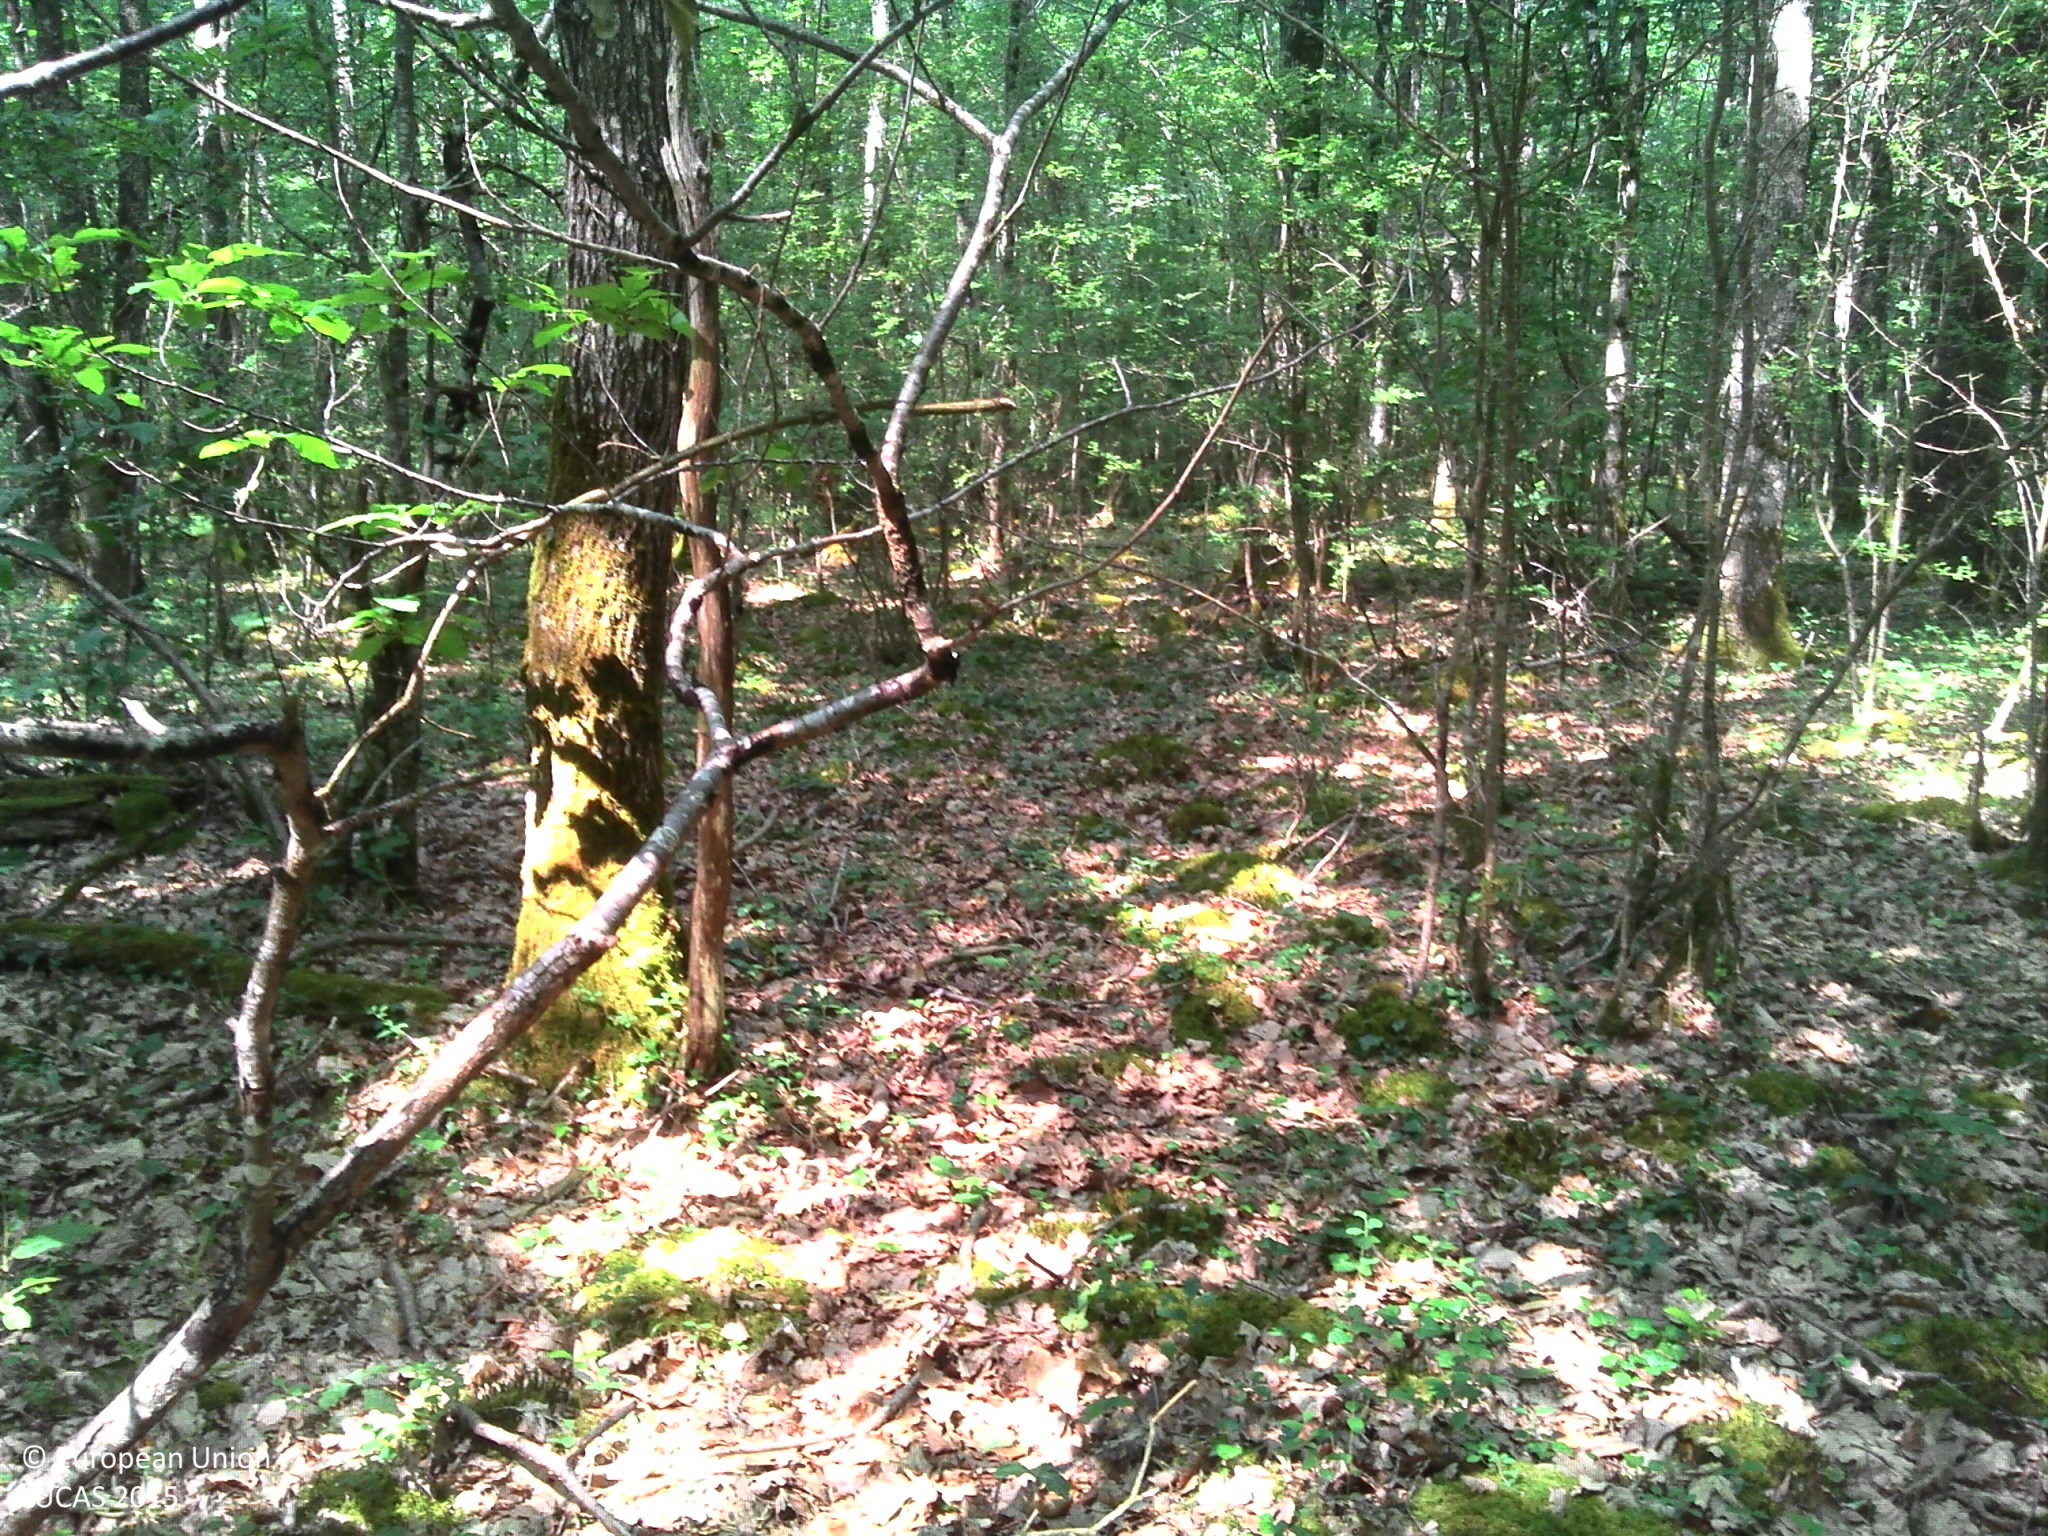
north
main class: Woodland
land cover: Broadleaved woodland
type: mesophytic deciduous forest
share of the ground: > 75 %
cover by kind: broadleaved forest trees 85 %, herbaceous plants 10 %, coniferous forest trees 5 %
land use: Forestry
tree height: > 5 m
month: June
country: FR
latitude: 47.6285
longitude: 0.6775
